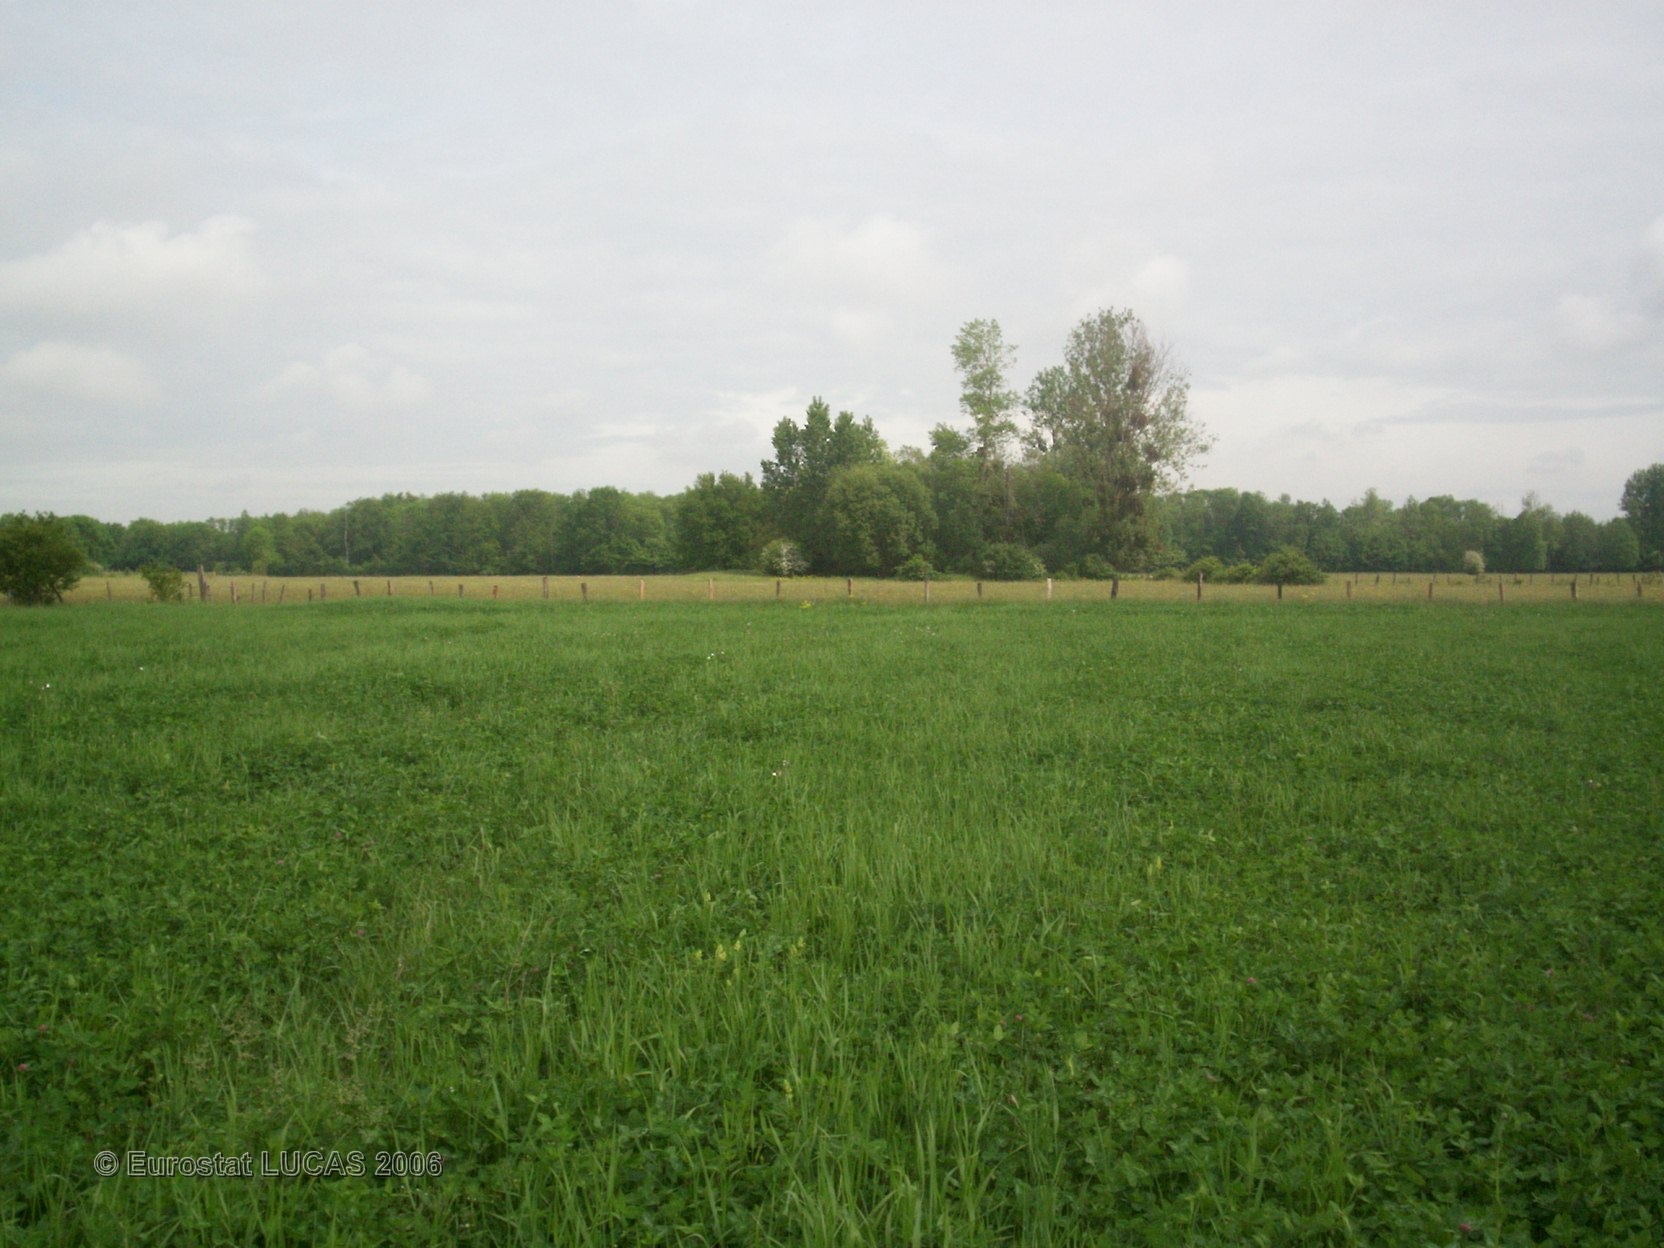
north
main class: Cropland
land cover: Clovers
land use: Agriculture (excluding fallow land and kitchen gardens)
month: May
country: FR
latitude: 48.6610
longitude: 4.8251
